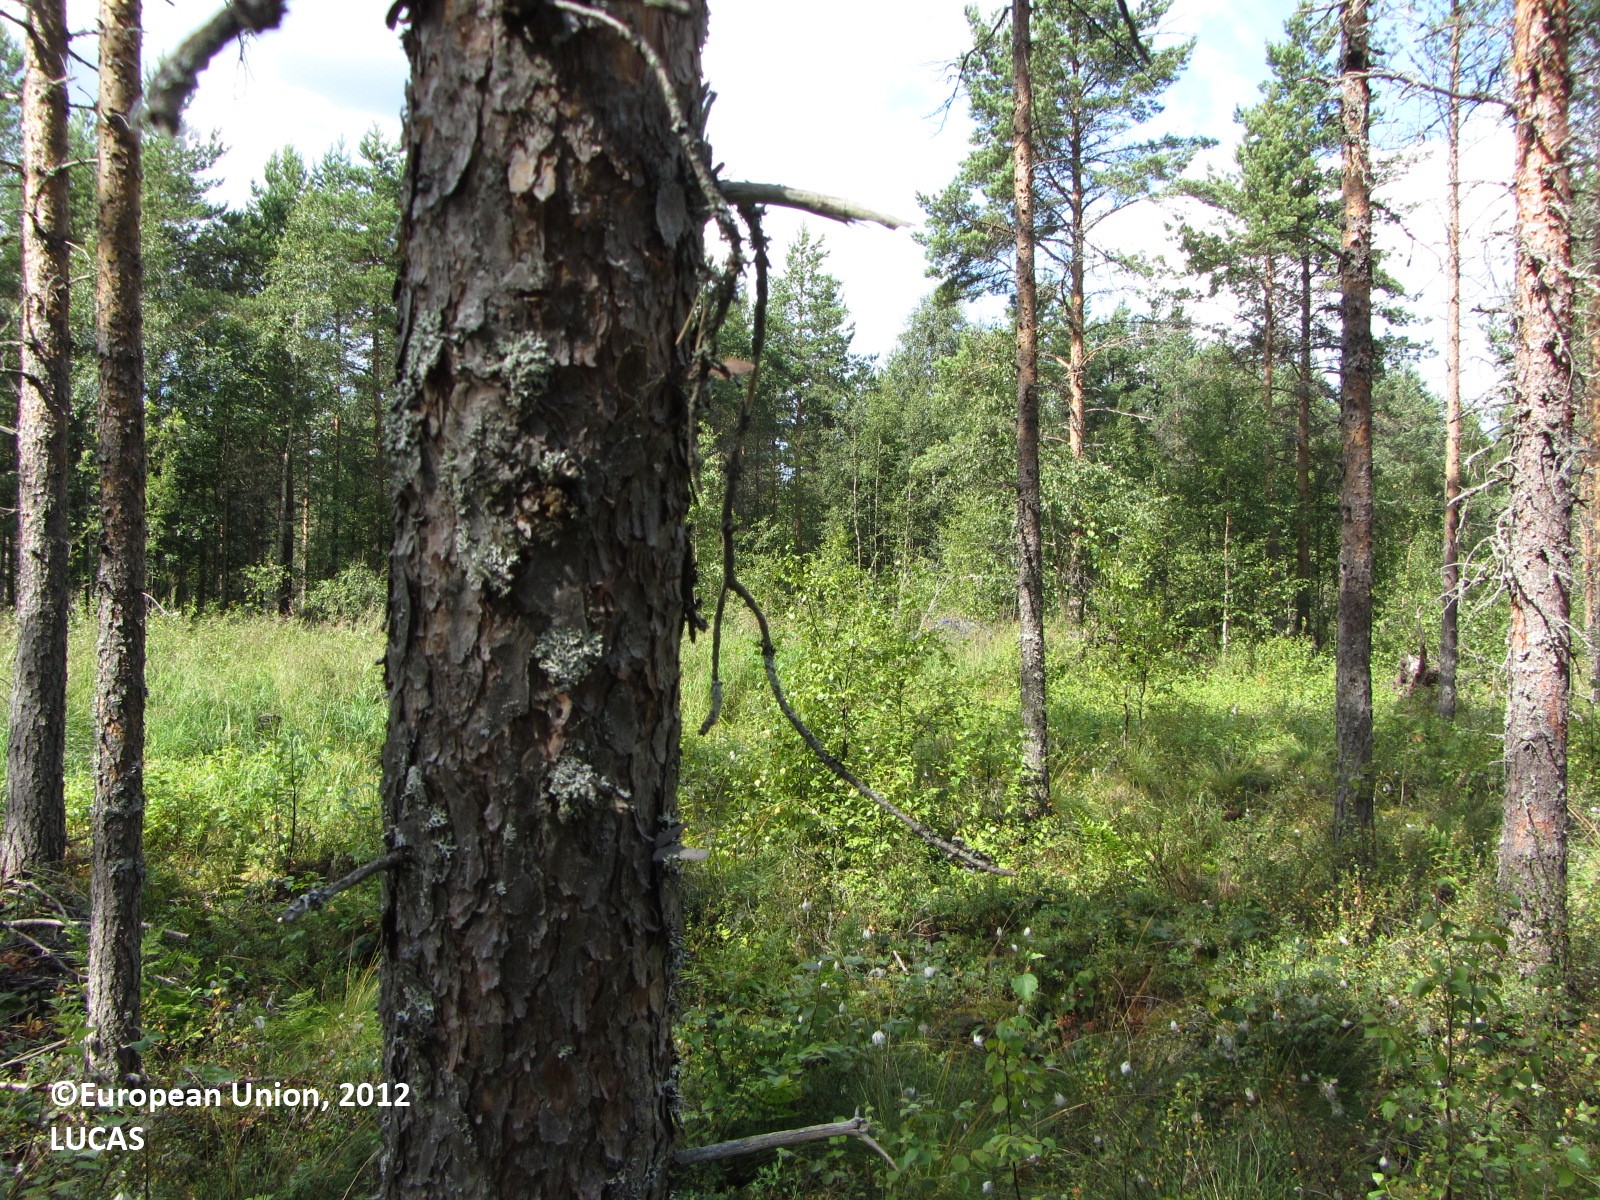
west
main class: Woodland
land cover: Pine dominated mixed woodland
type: boreal forest
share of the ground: 50 - 75 %
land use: Forestry
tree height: > 5 m
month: July
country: FI
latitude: 63.6445
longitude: 24.5968
